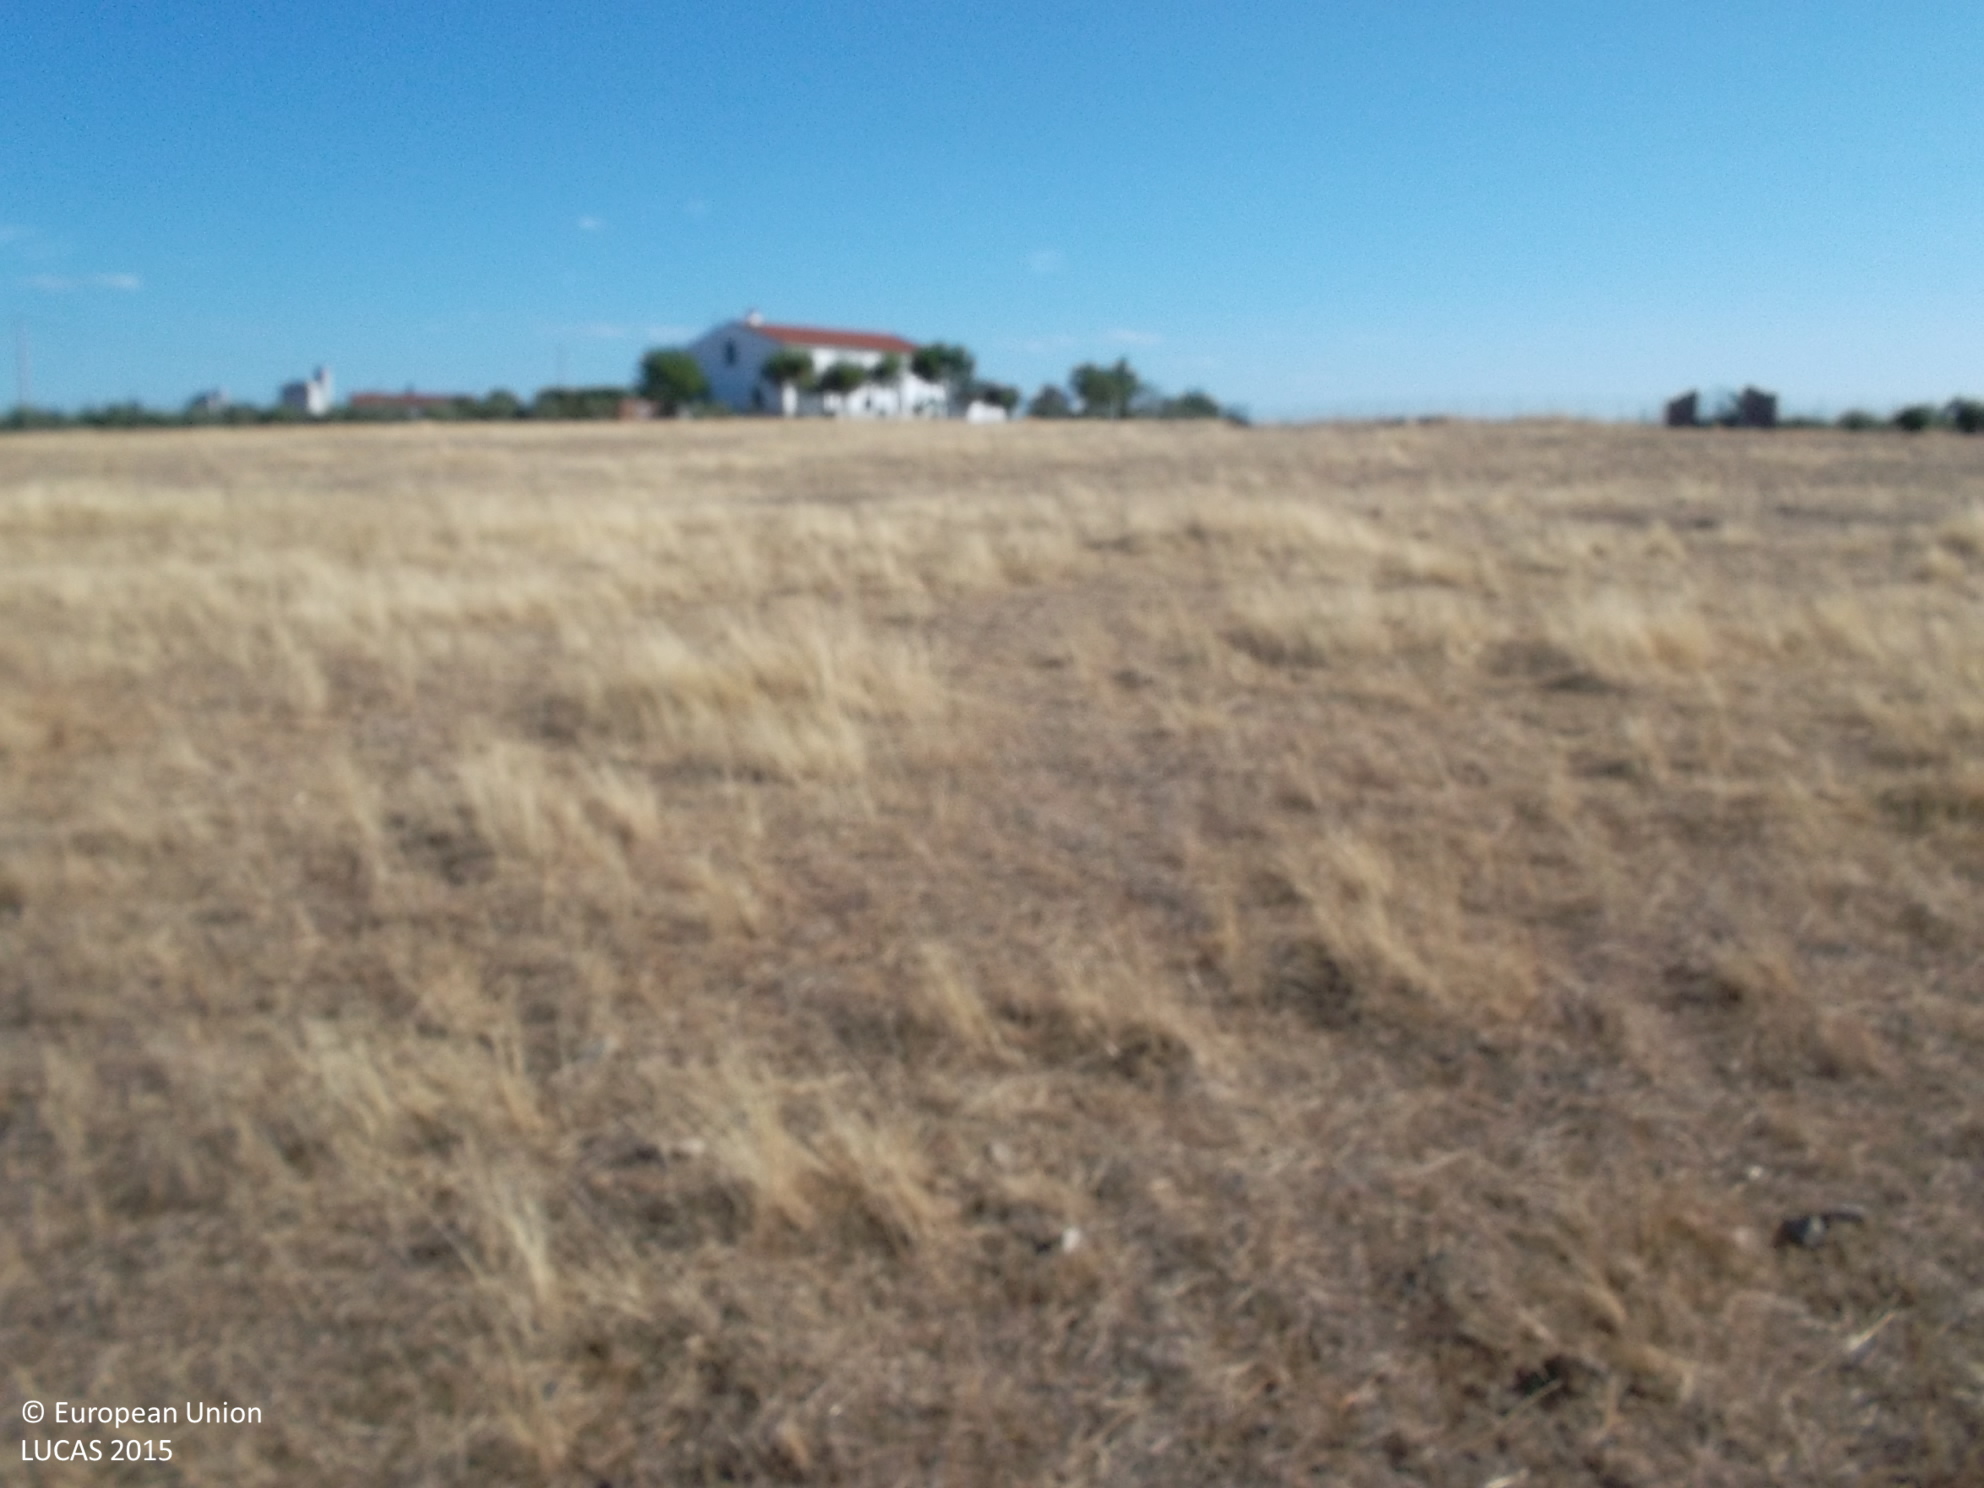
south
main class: Grassland
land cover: Spontaneously vegetated surfaces
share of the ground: > 75 %
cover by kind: herbaceous plants 100 %
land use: Agriculture (excluding fallow land and kitchen gardens)
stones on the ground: 10 - 25 %
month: July
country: ES
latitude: 38.2793
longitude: -5.6845
